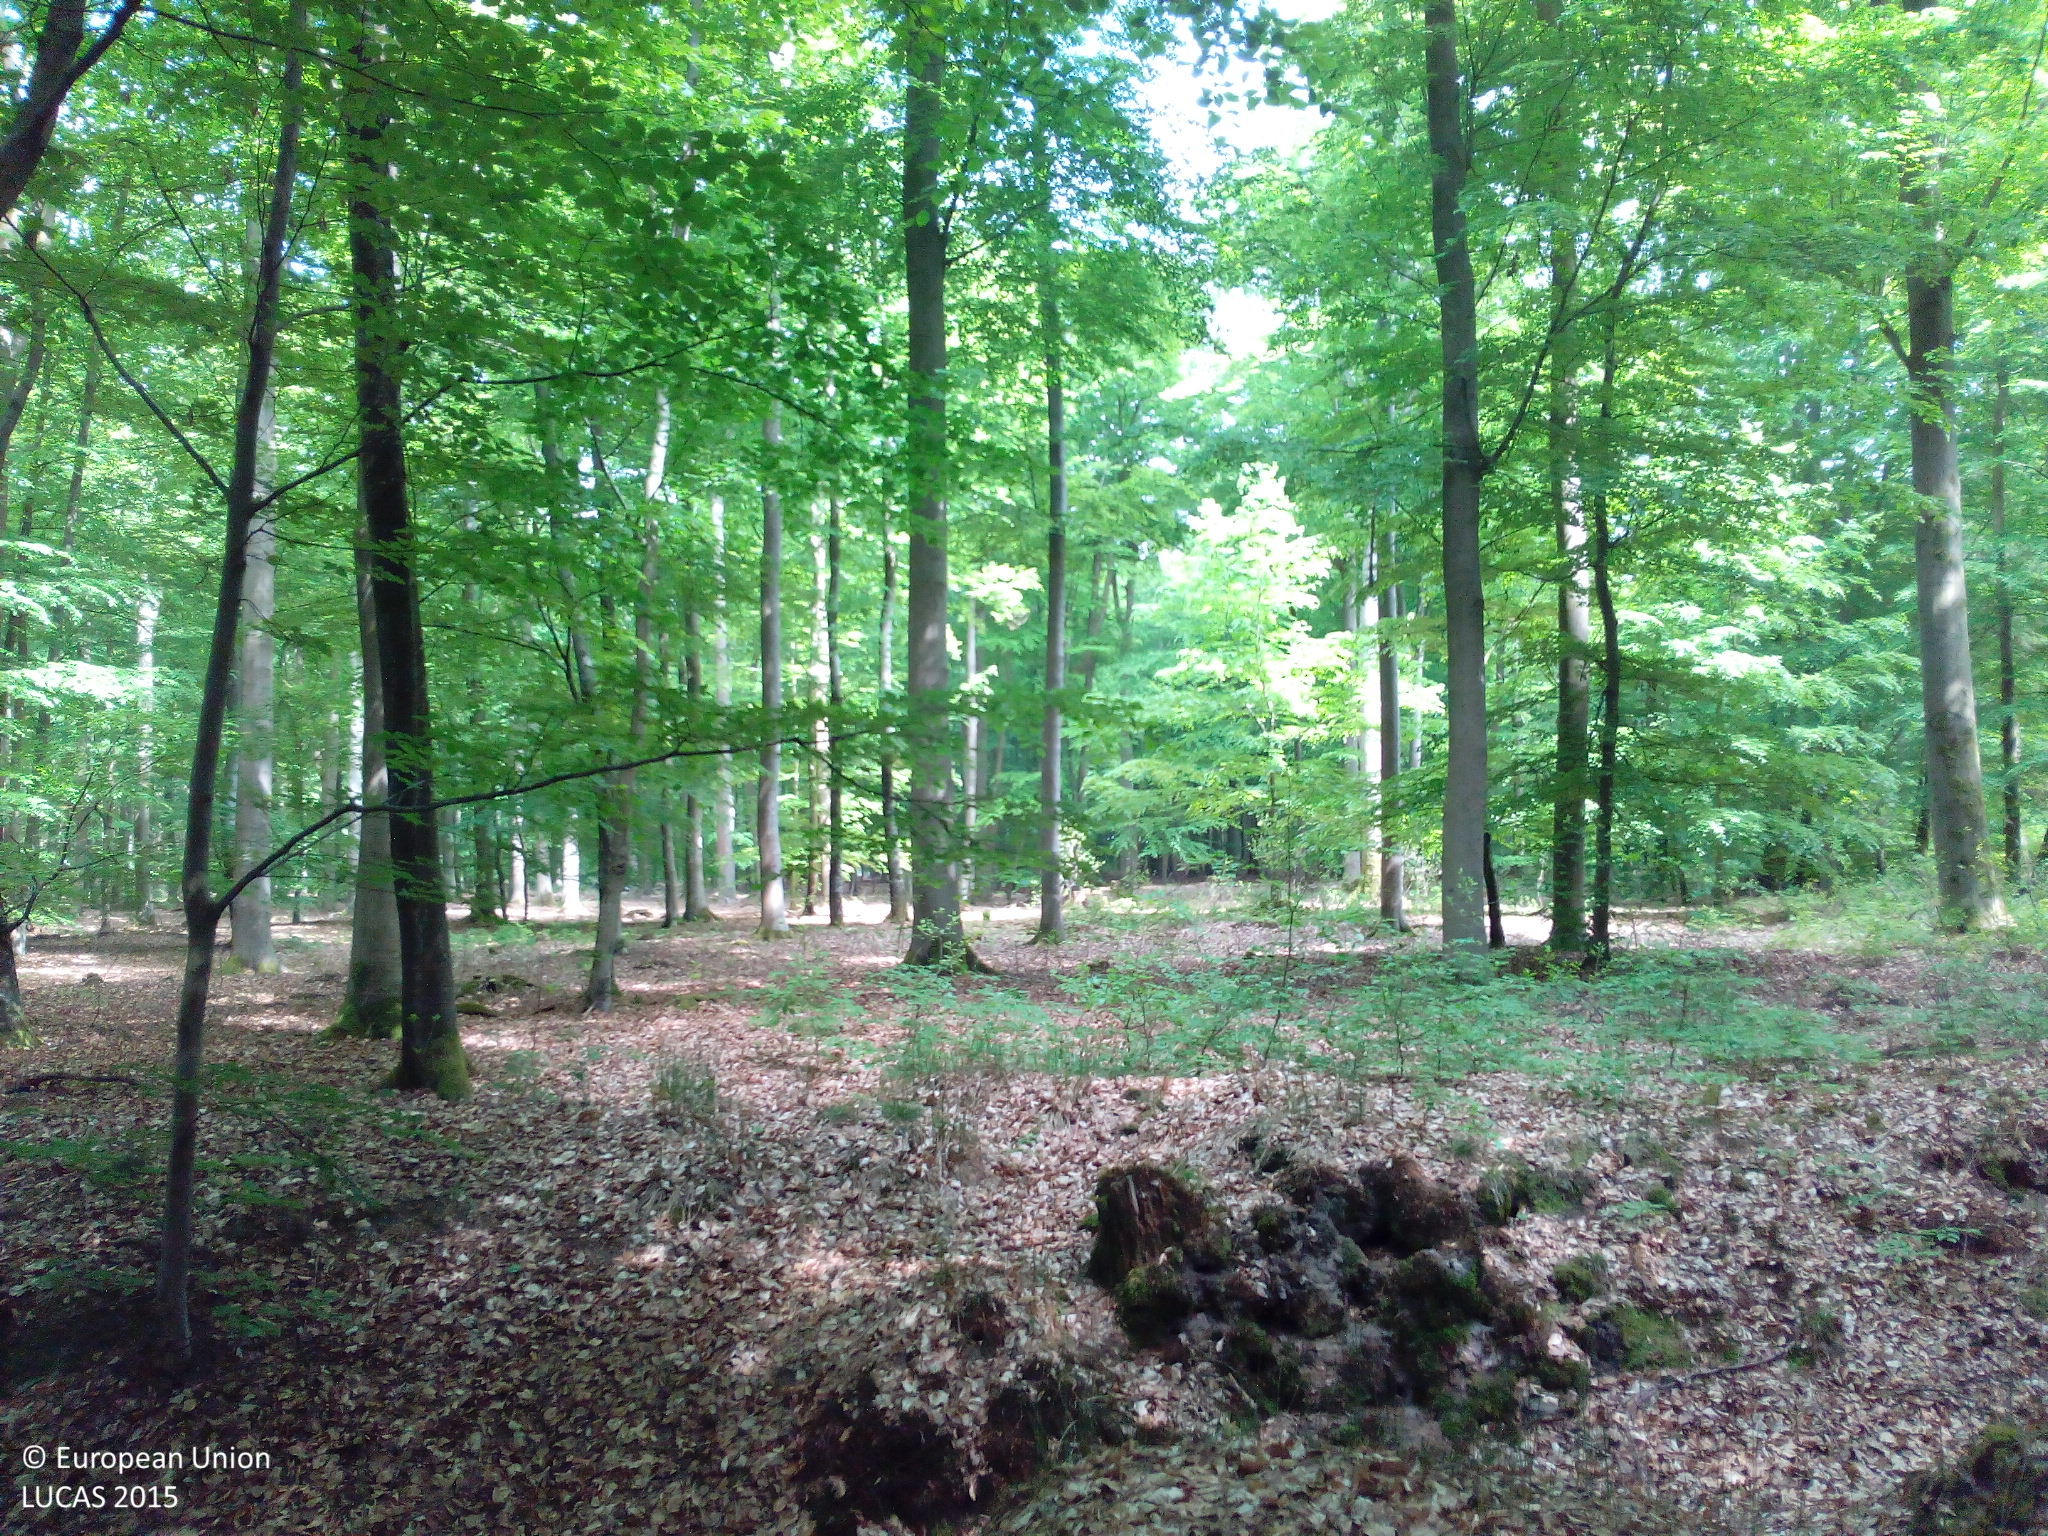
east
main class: Woodland
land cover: Broadleaved woodland
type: beech forest
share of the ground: 25 - 50 %
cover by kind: broadleaved forest trees 80 %, unconsolidated bare surface 20 %
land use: Forestry
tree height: > 5 m
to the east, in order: Broadleaved woodland
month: May
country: DE
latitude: 53.4987
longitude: 11.6425
